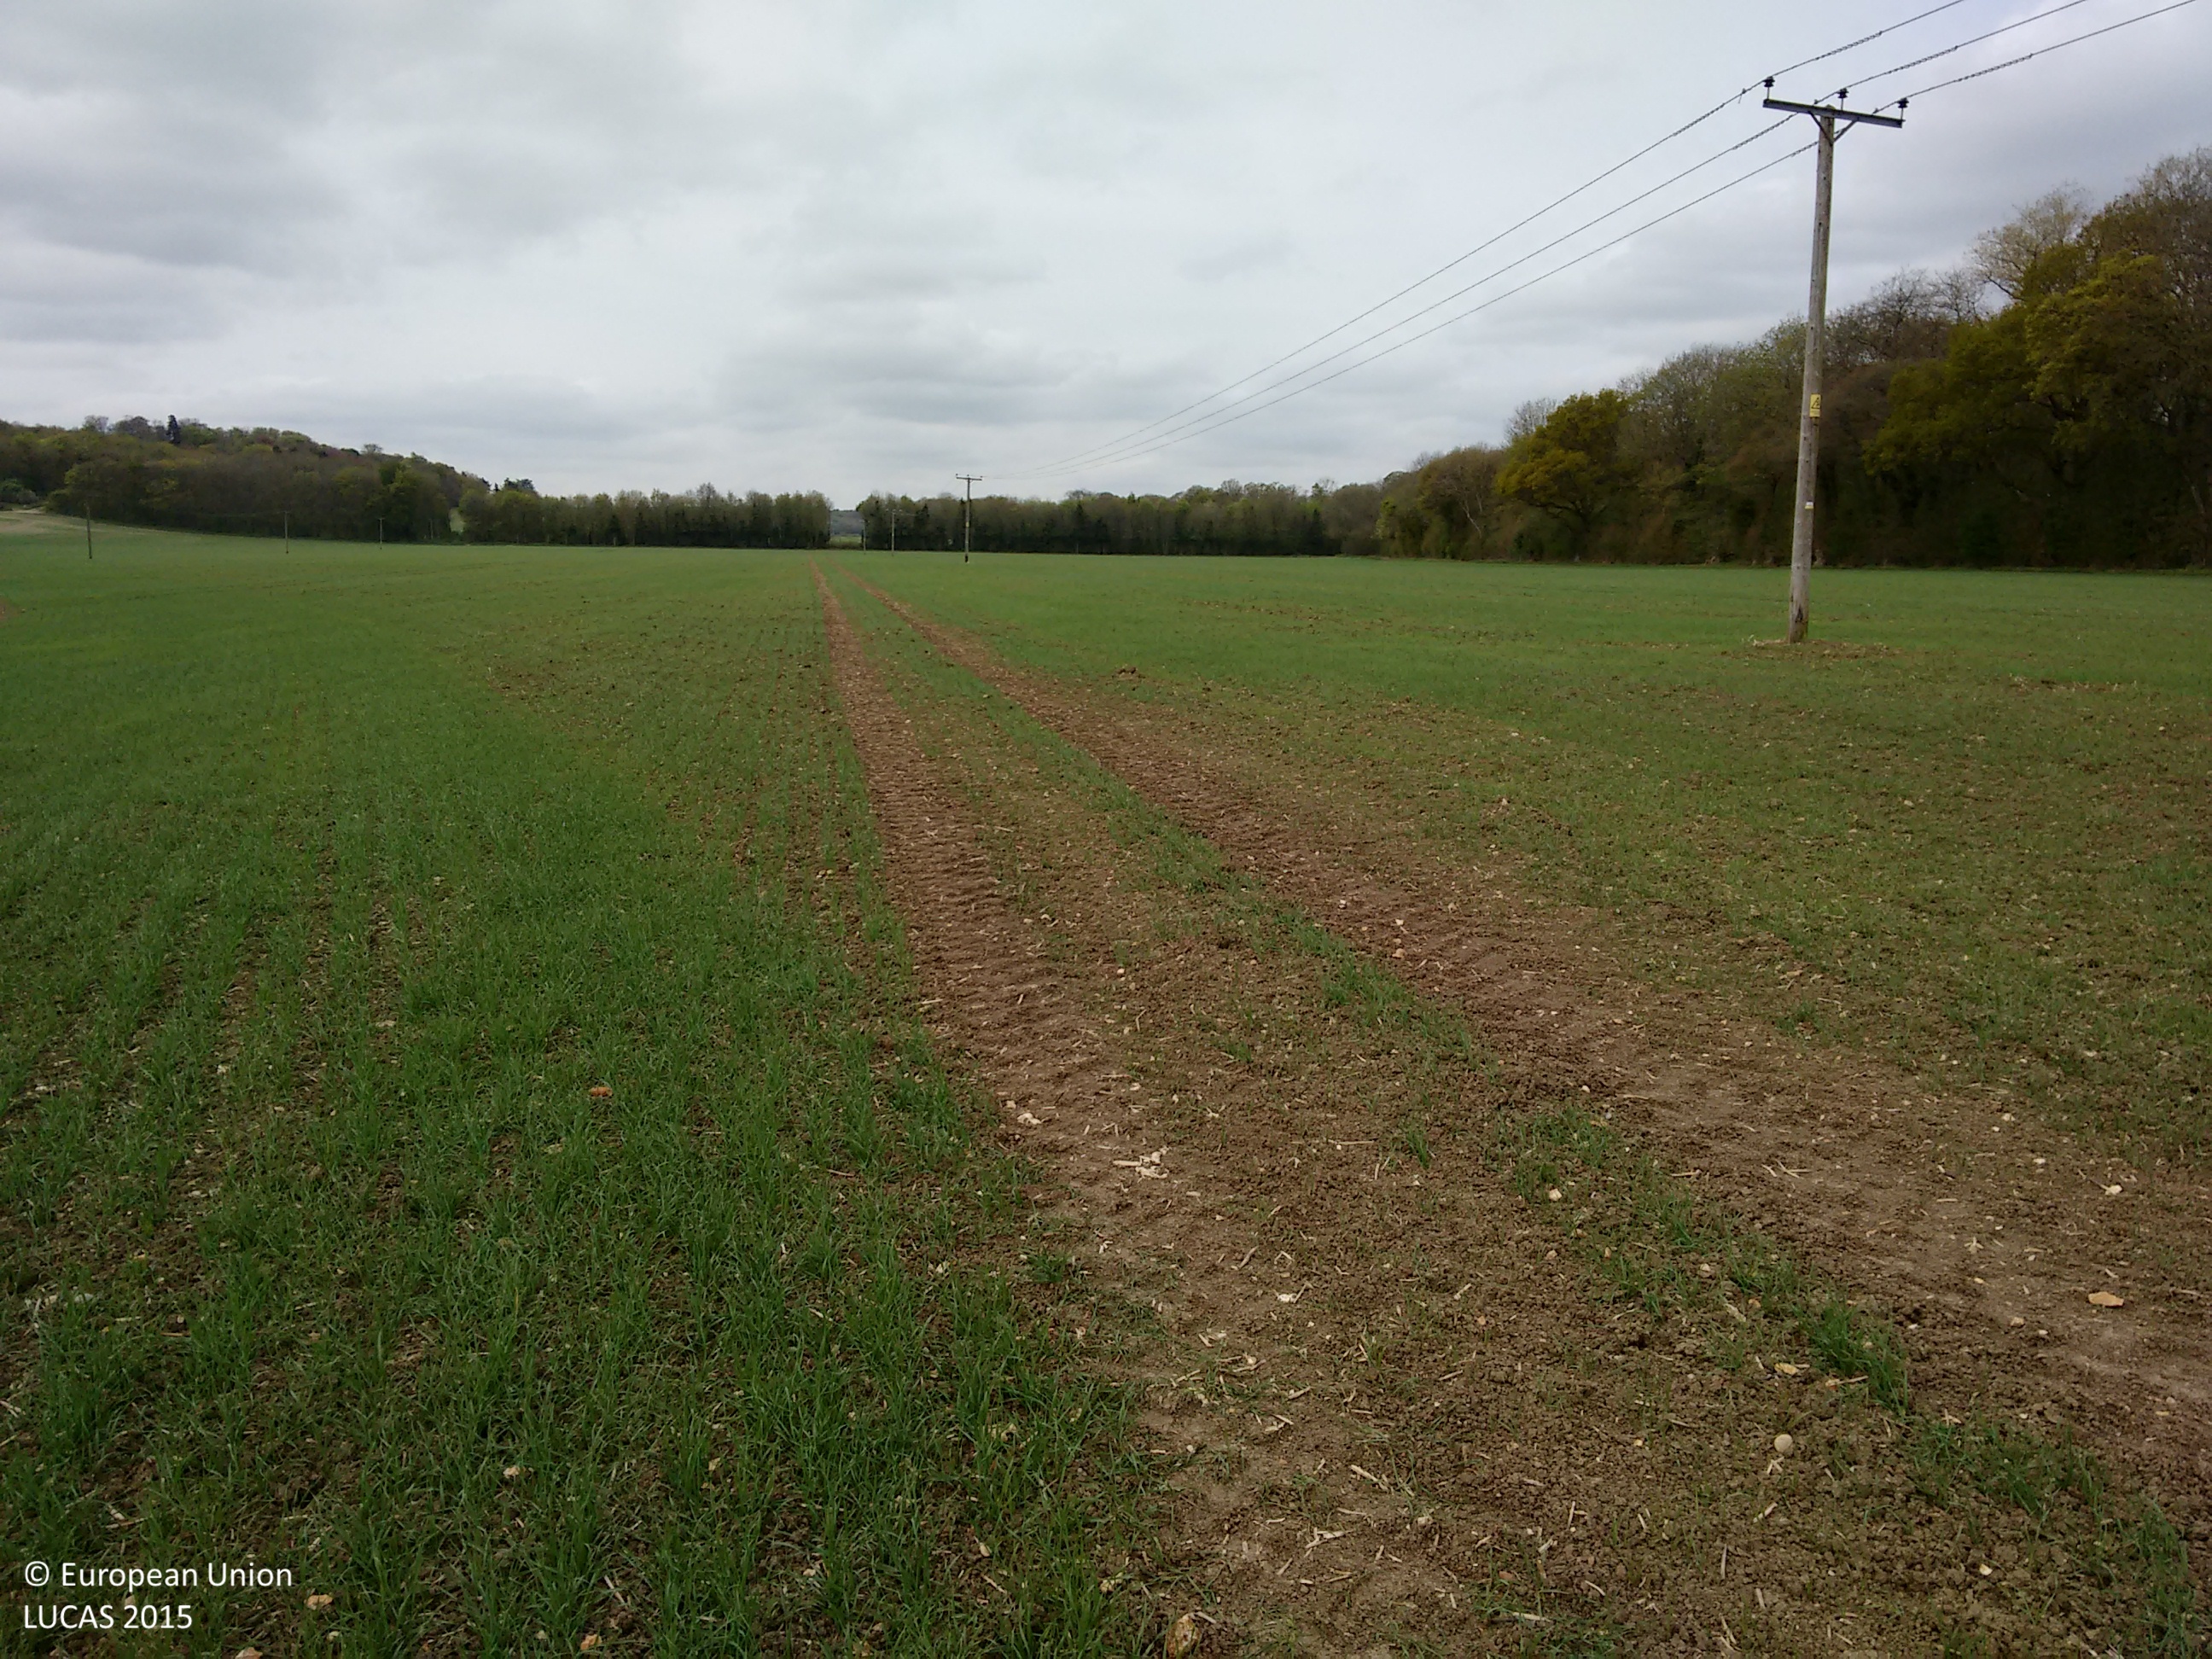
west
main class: Cropland
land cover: Common wheat
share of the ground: 50 - 75 %
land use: Agriculture (excluding fallow land and kitchen gardens)
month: May
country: GB
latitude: 51.1229
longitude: -0.9741
